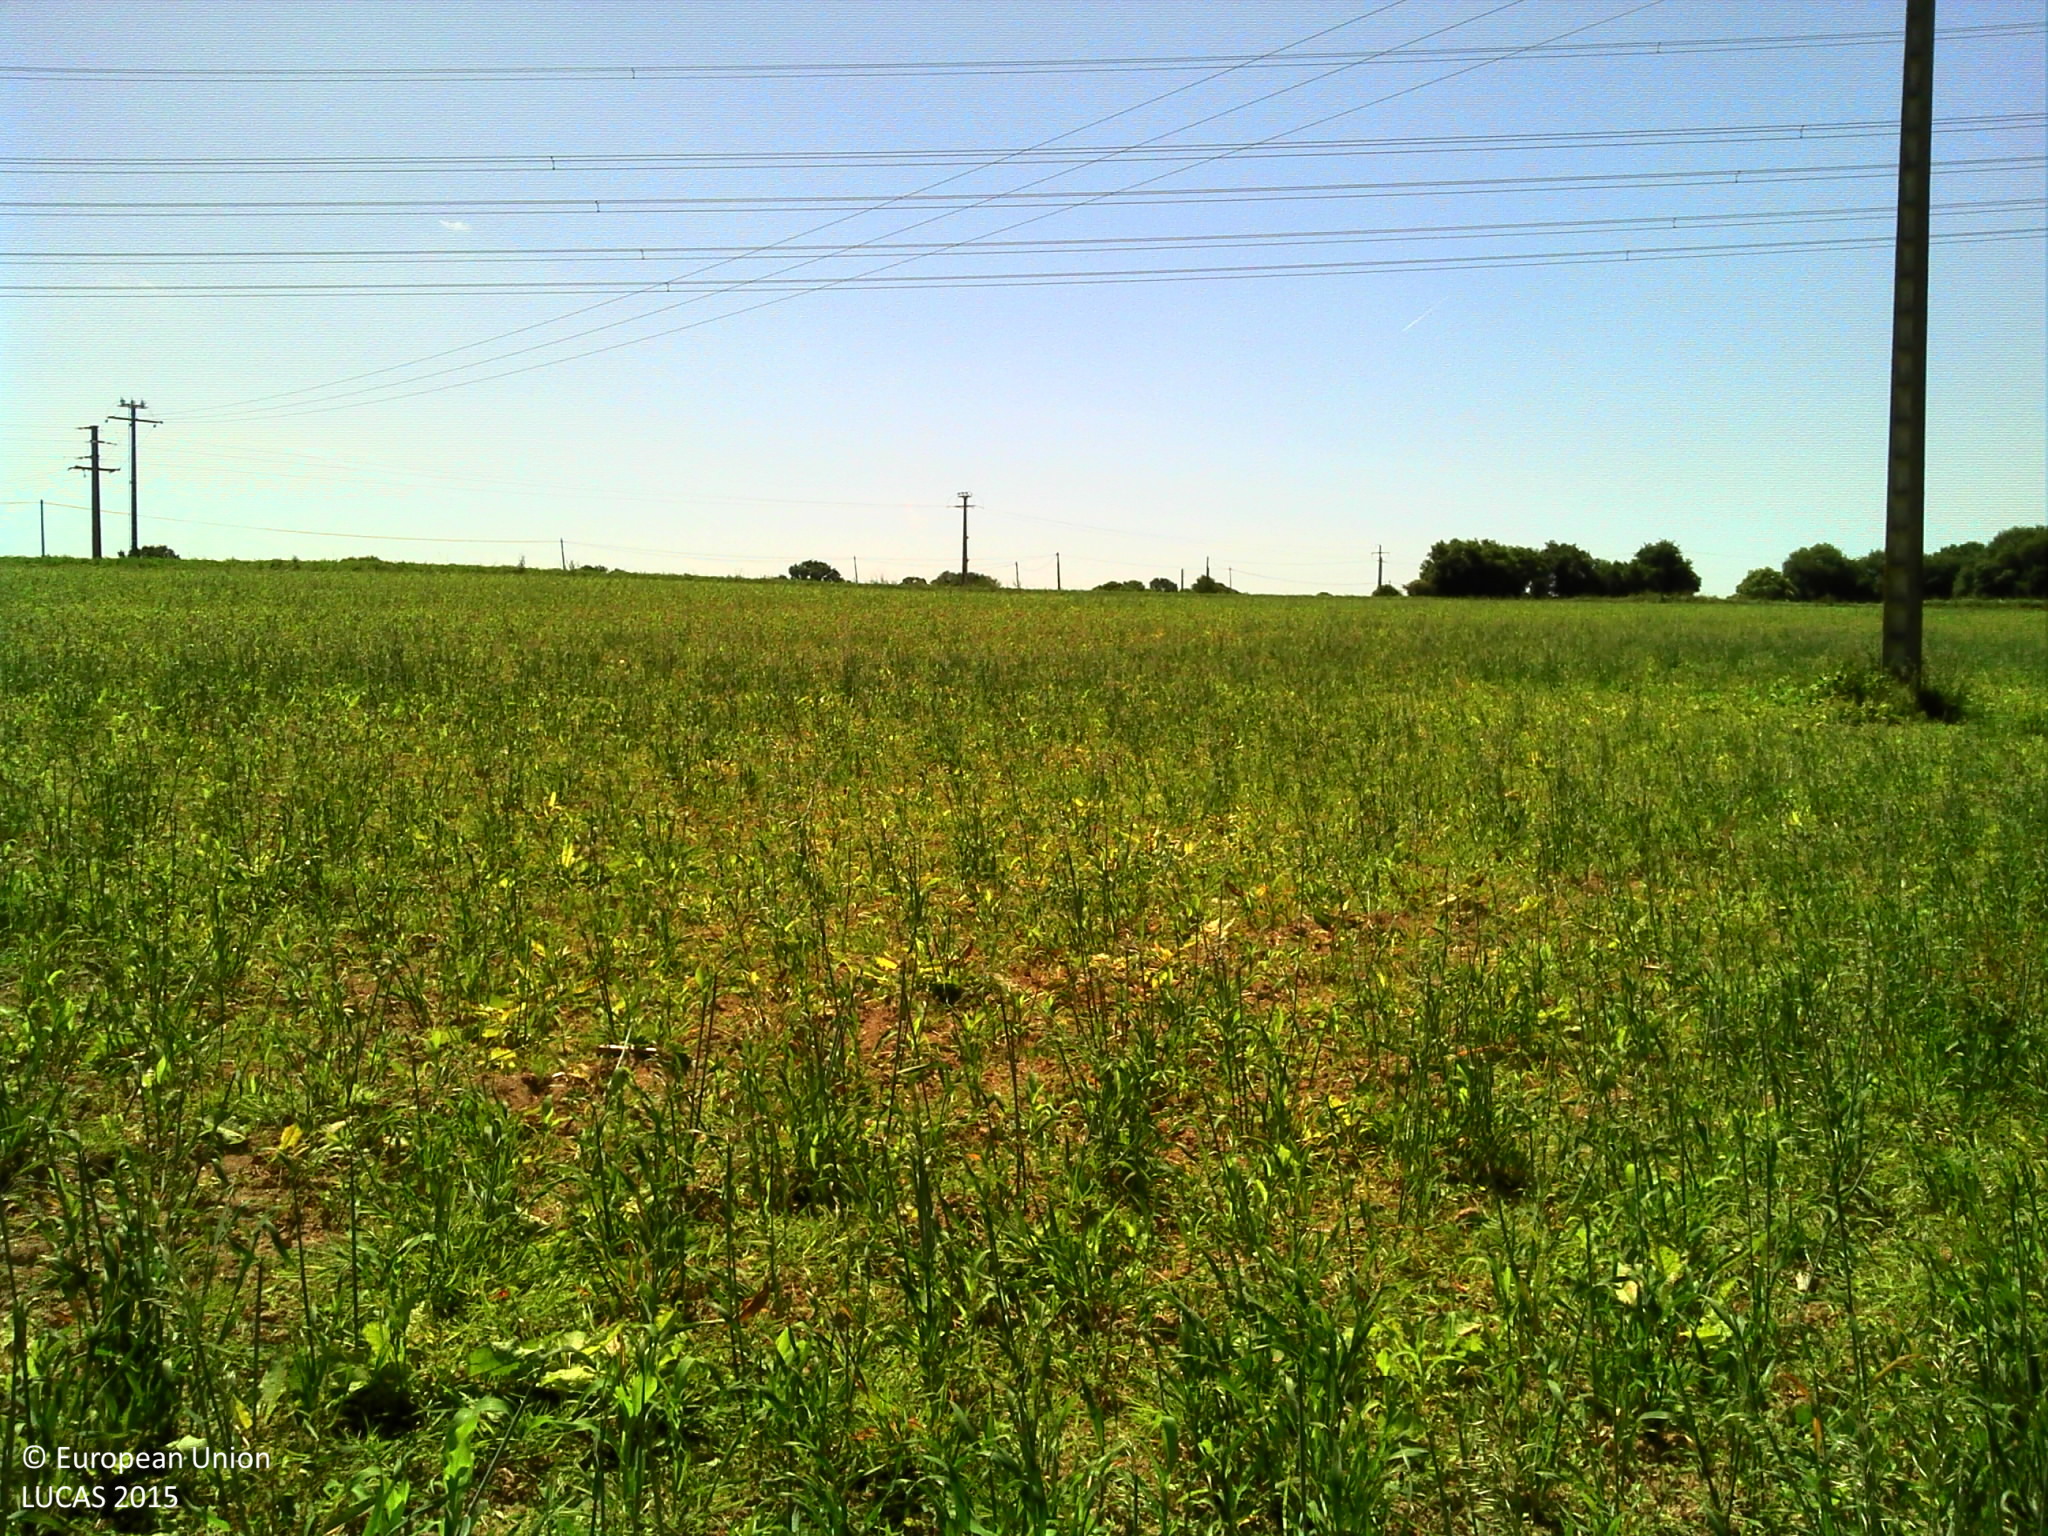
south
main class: Cropland
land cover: Maize
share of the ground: > 75 %
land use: Agriculture (excluding fallow land and kitchen gardens)
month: June
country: FR
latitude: 48.0950
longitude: -1.4717
